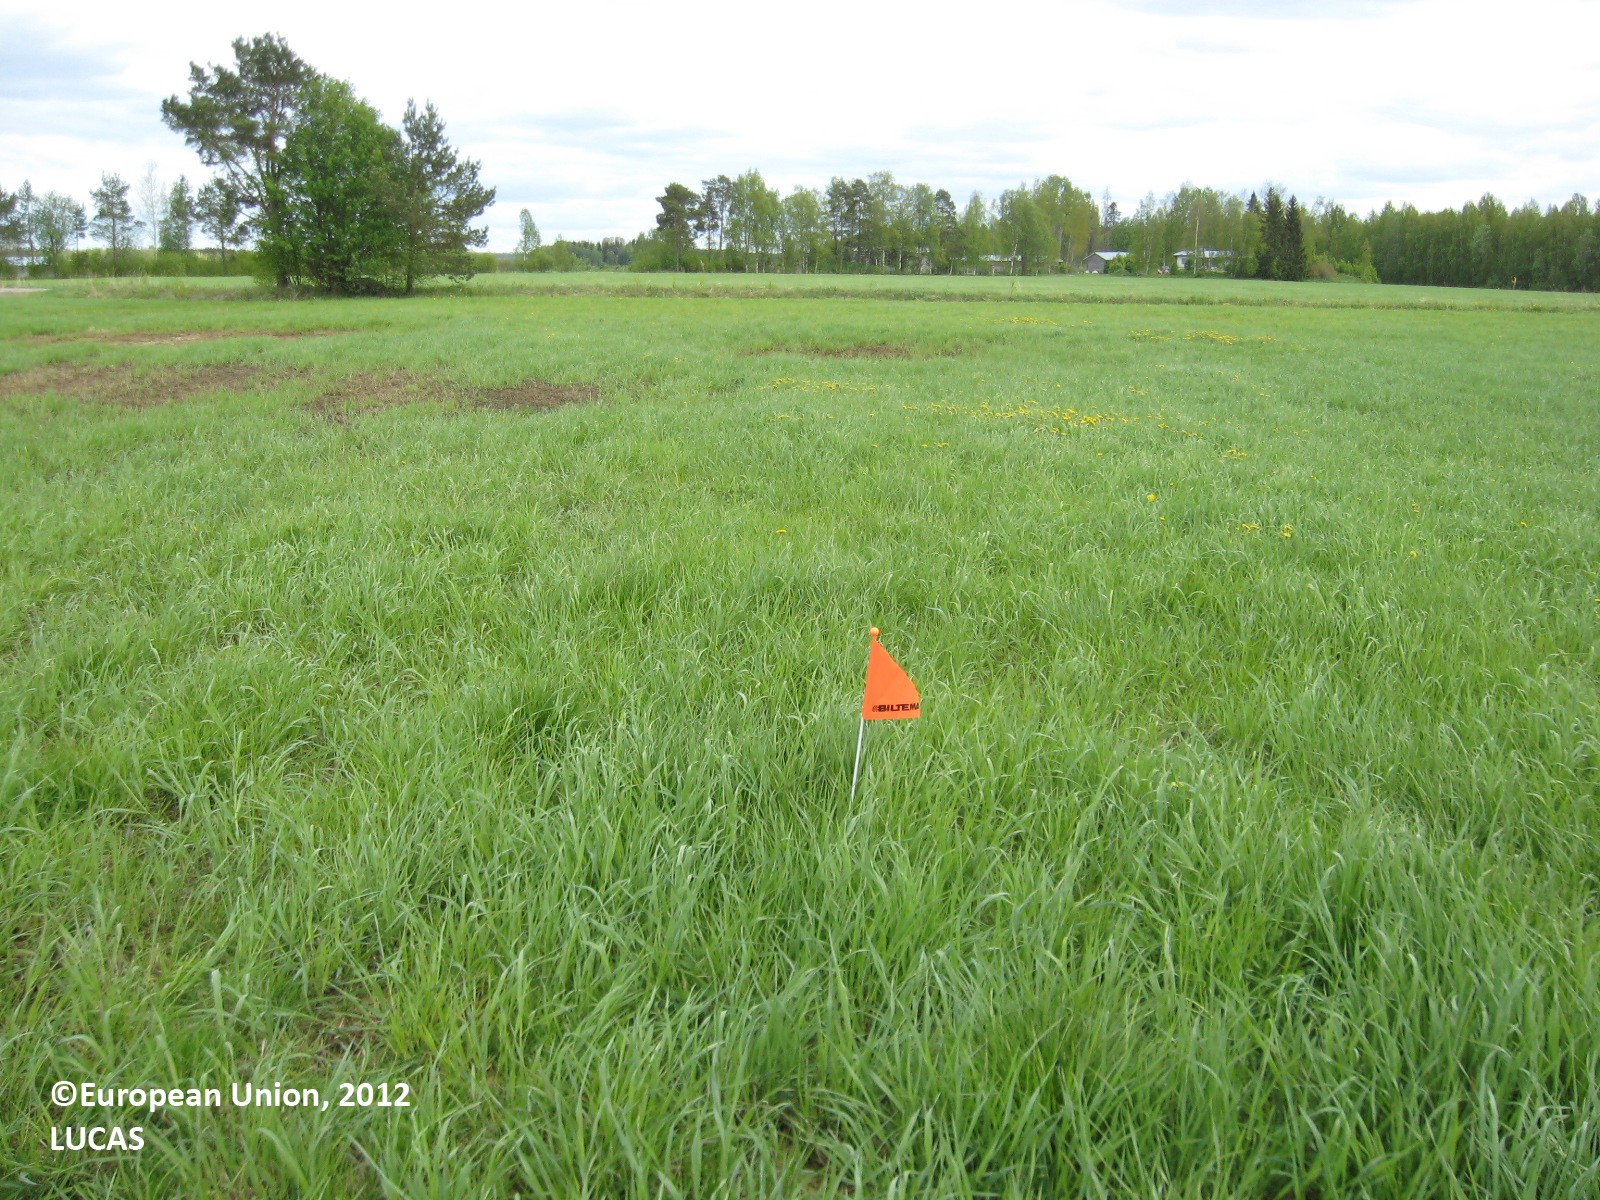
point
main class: Cropland
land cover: Temporary grasslands
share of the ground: > 75 %
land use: Agriculture (excluding fallow land and kitchen gardens)
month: May
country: FI
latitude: 61.8122
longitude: 22.5295
